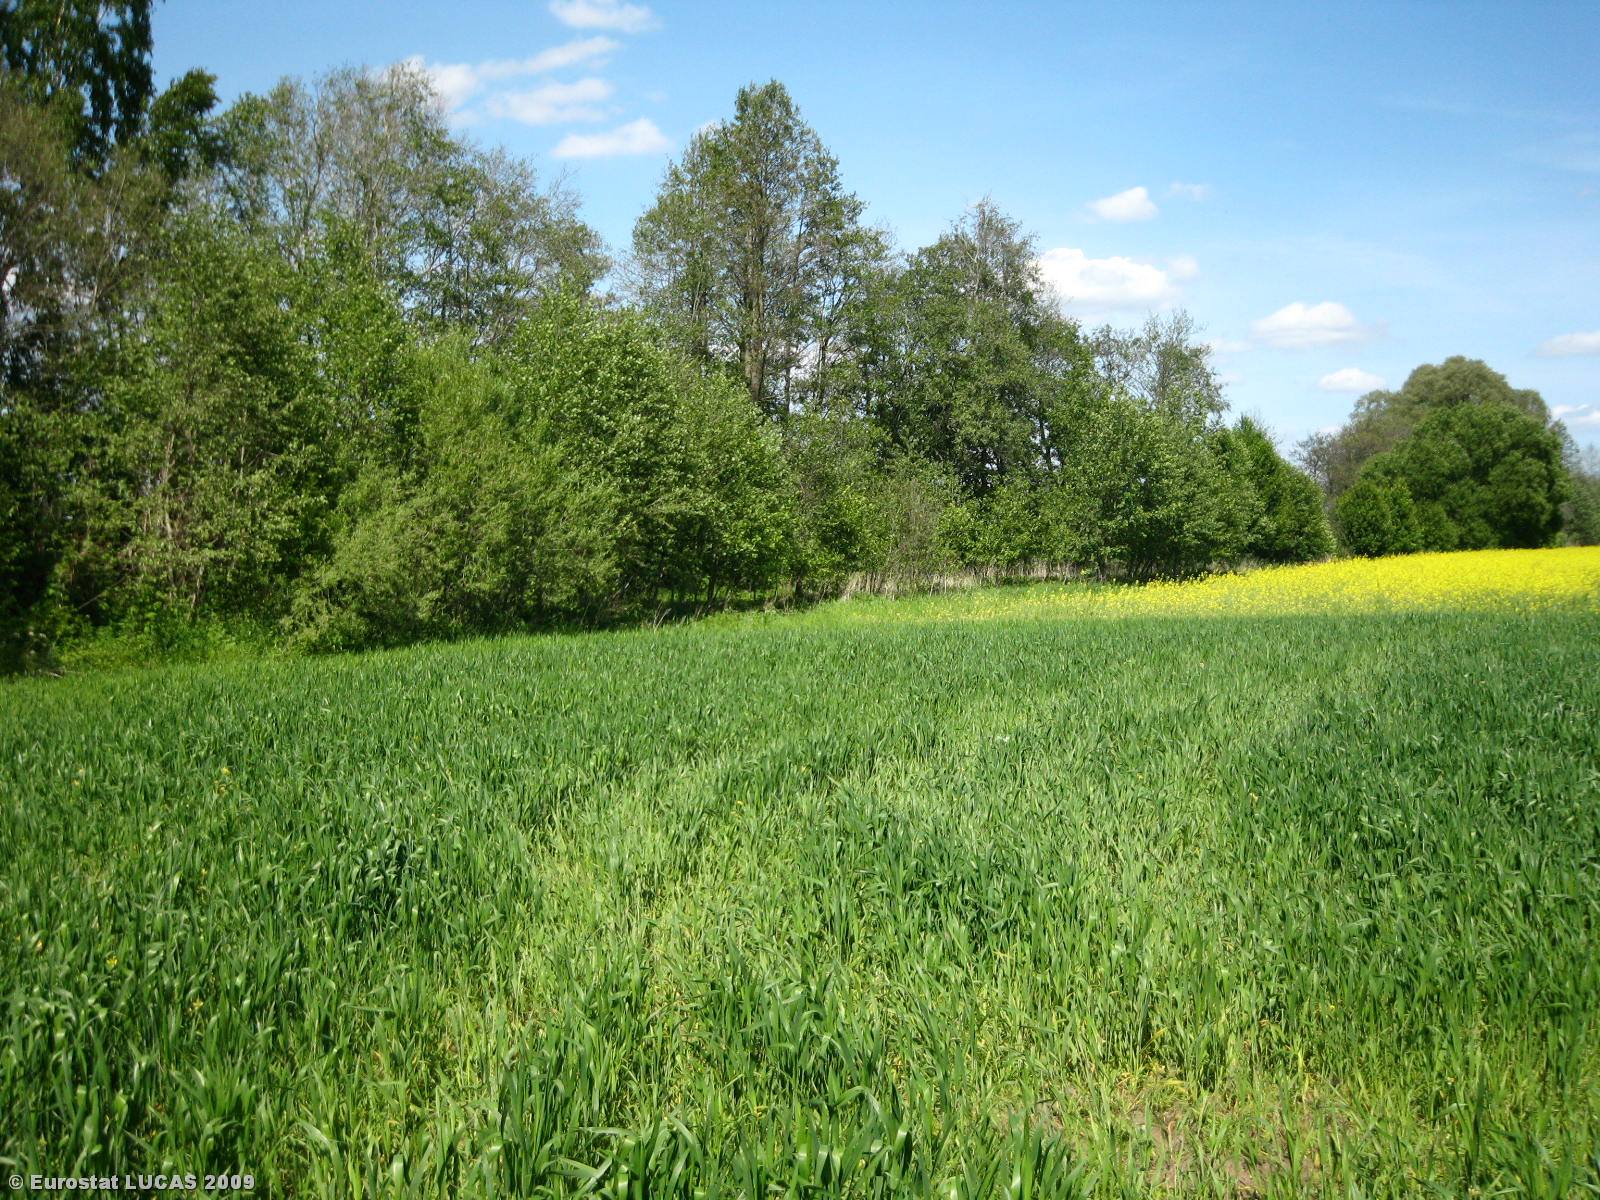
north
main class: Cropland
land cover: Common wheat
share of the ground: > 75 %
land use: Agriculture (excluding fallow land and kitchen gardens)
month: May
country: LT
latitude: 55.8112
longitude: 23.8884
